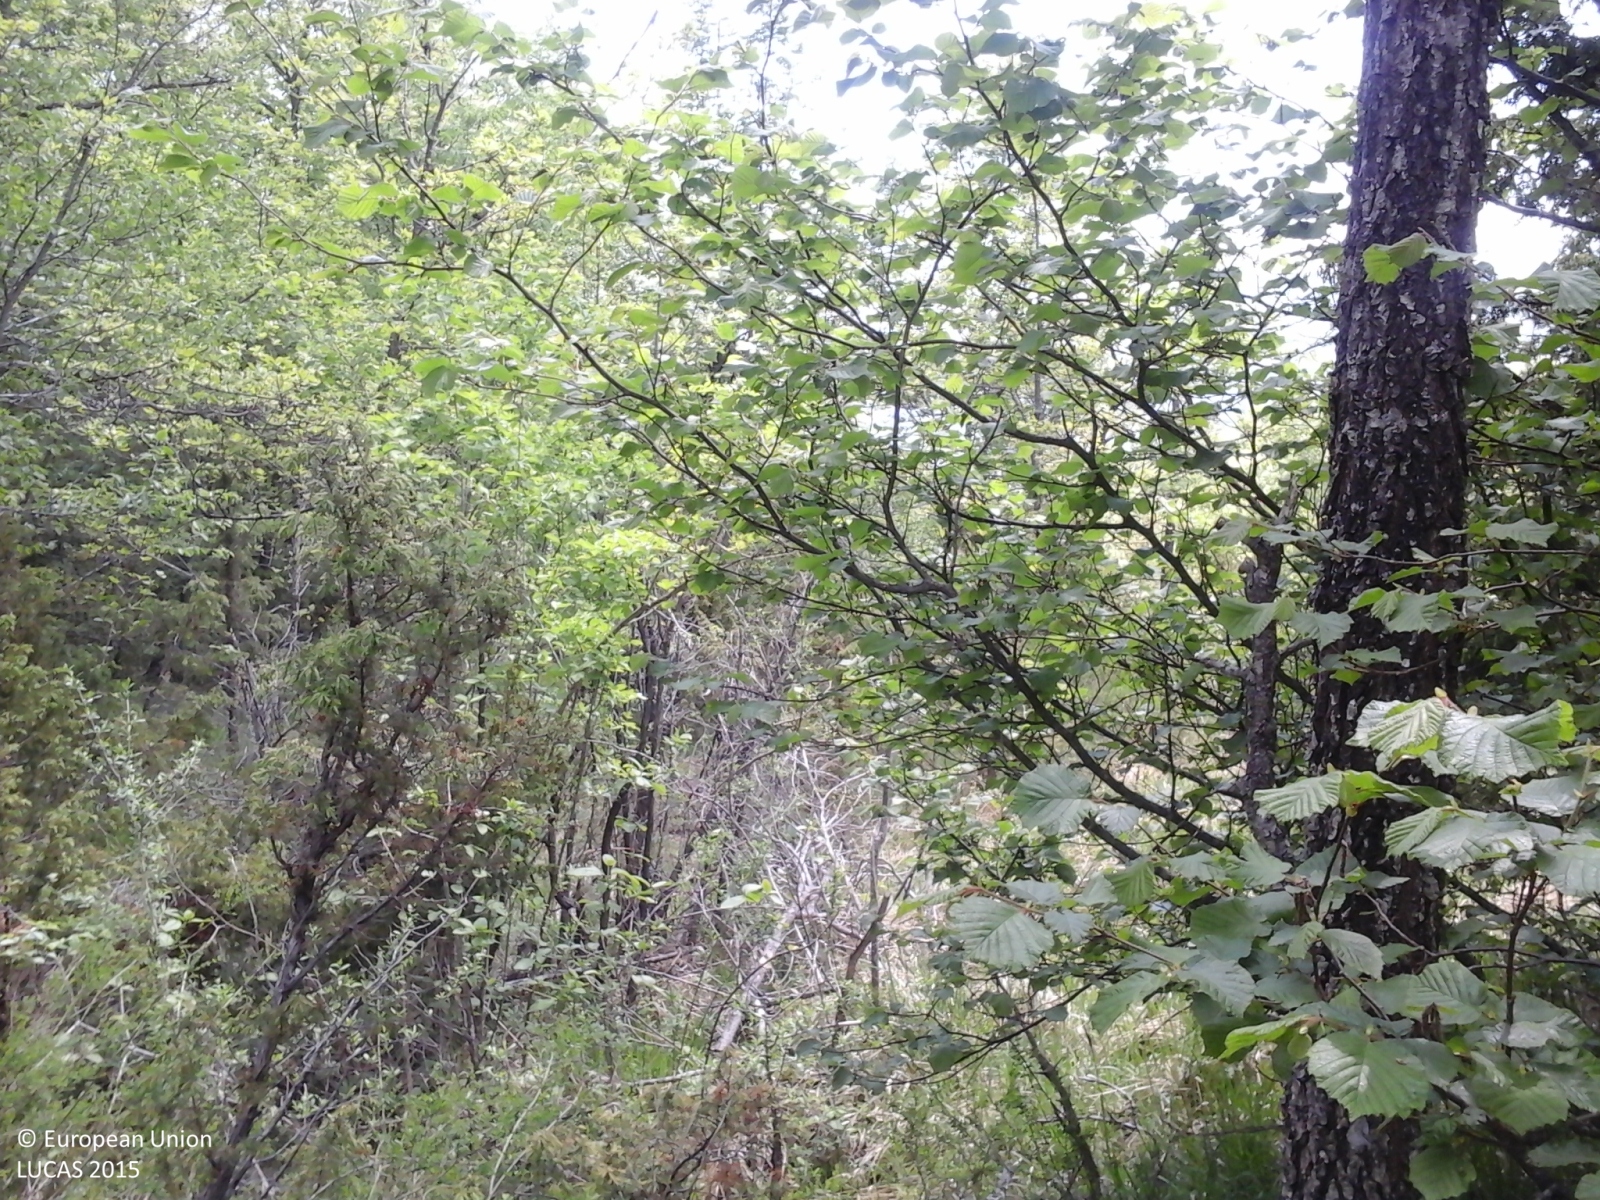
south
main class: Woodland
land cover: Broadleaved woodland
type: thermophilous deciduous forest
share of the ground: > 75 %
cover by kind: broadleaved forest trees 80 %, shrubs 15 %, herbaceous plants 5 %
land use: Forestry
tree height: > 5 m
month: May
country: IT
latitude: 44.7644
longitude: 9.5587
